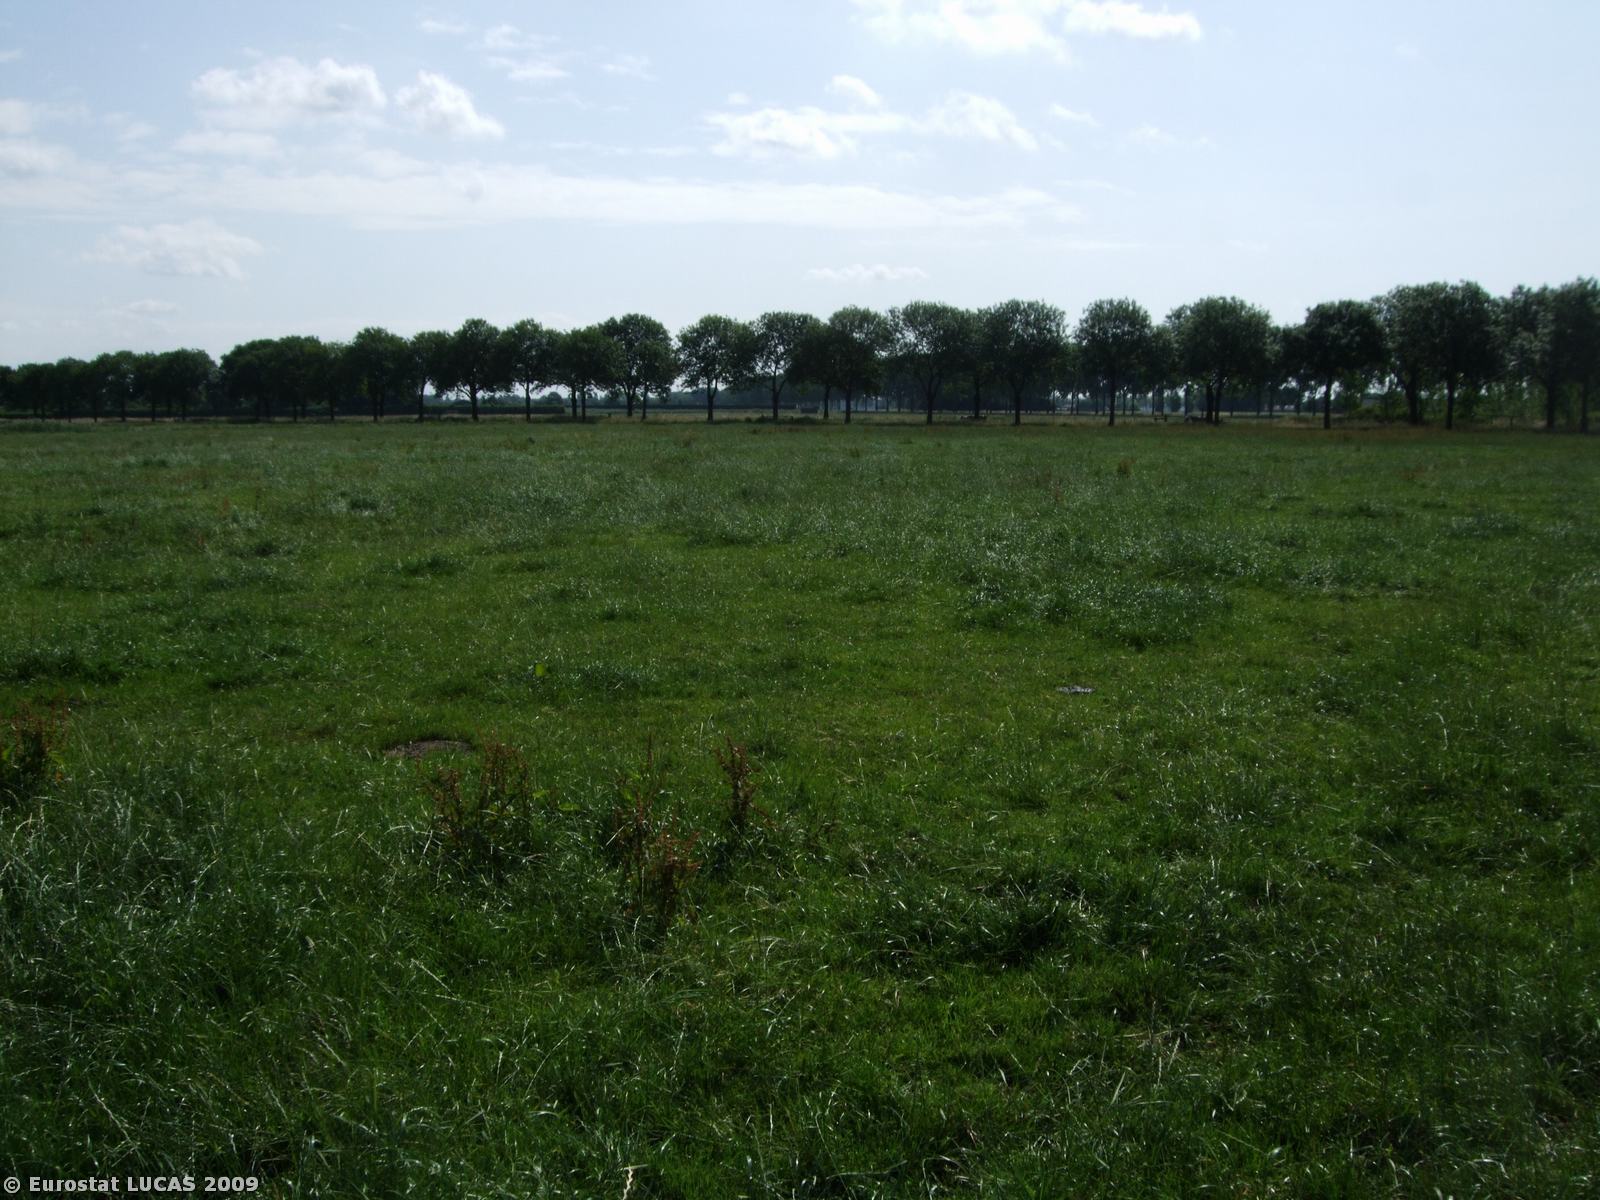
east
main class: Grassland
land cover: Grassland without tree/shrub cover
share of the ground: > 75 %
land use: Agriculture (excluding fallow land and kitchen gardens)
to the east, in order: Grassland without tree/shrub cover; Ditches and canals; Fences; Grassland without tree/shrub cover; Fences; Ditches and canals; Lines of trees; Grassland without tree/shrub cover; Paved roads, cycling and walking lanes; Lines of trees; Grass margins
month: July
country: NL
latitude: 51.9435
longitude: 5.3282
